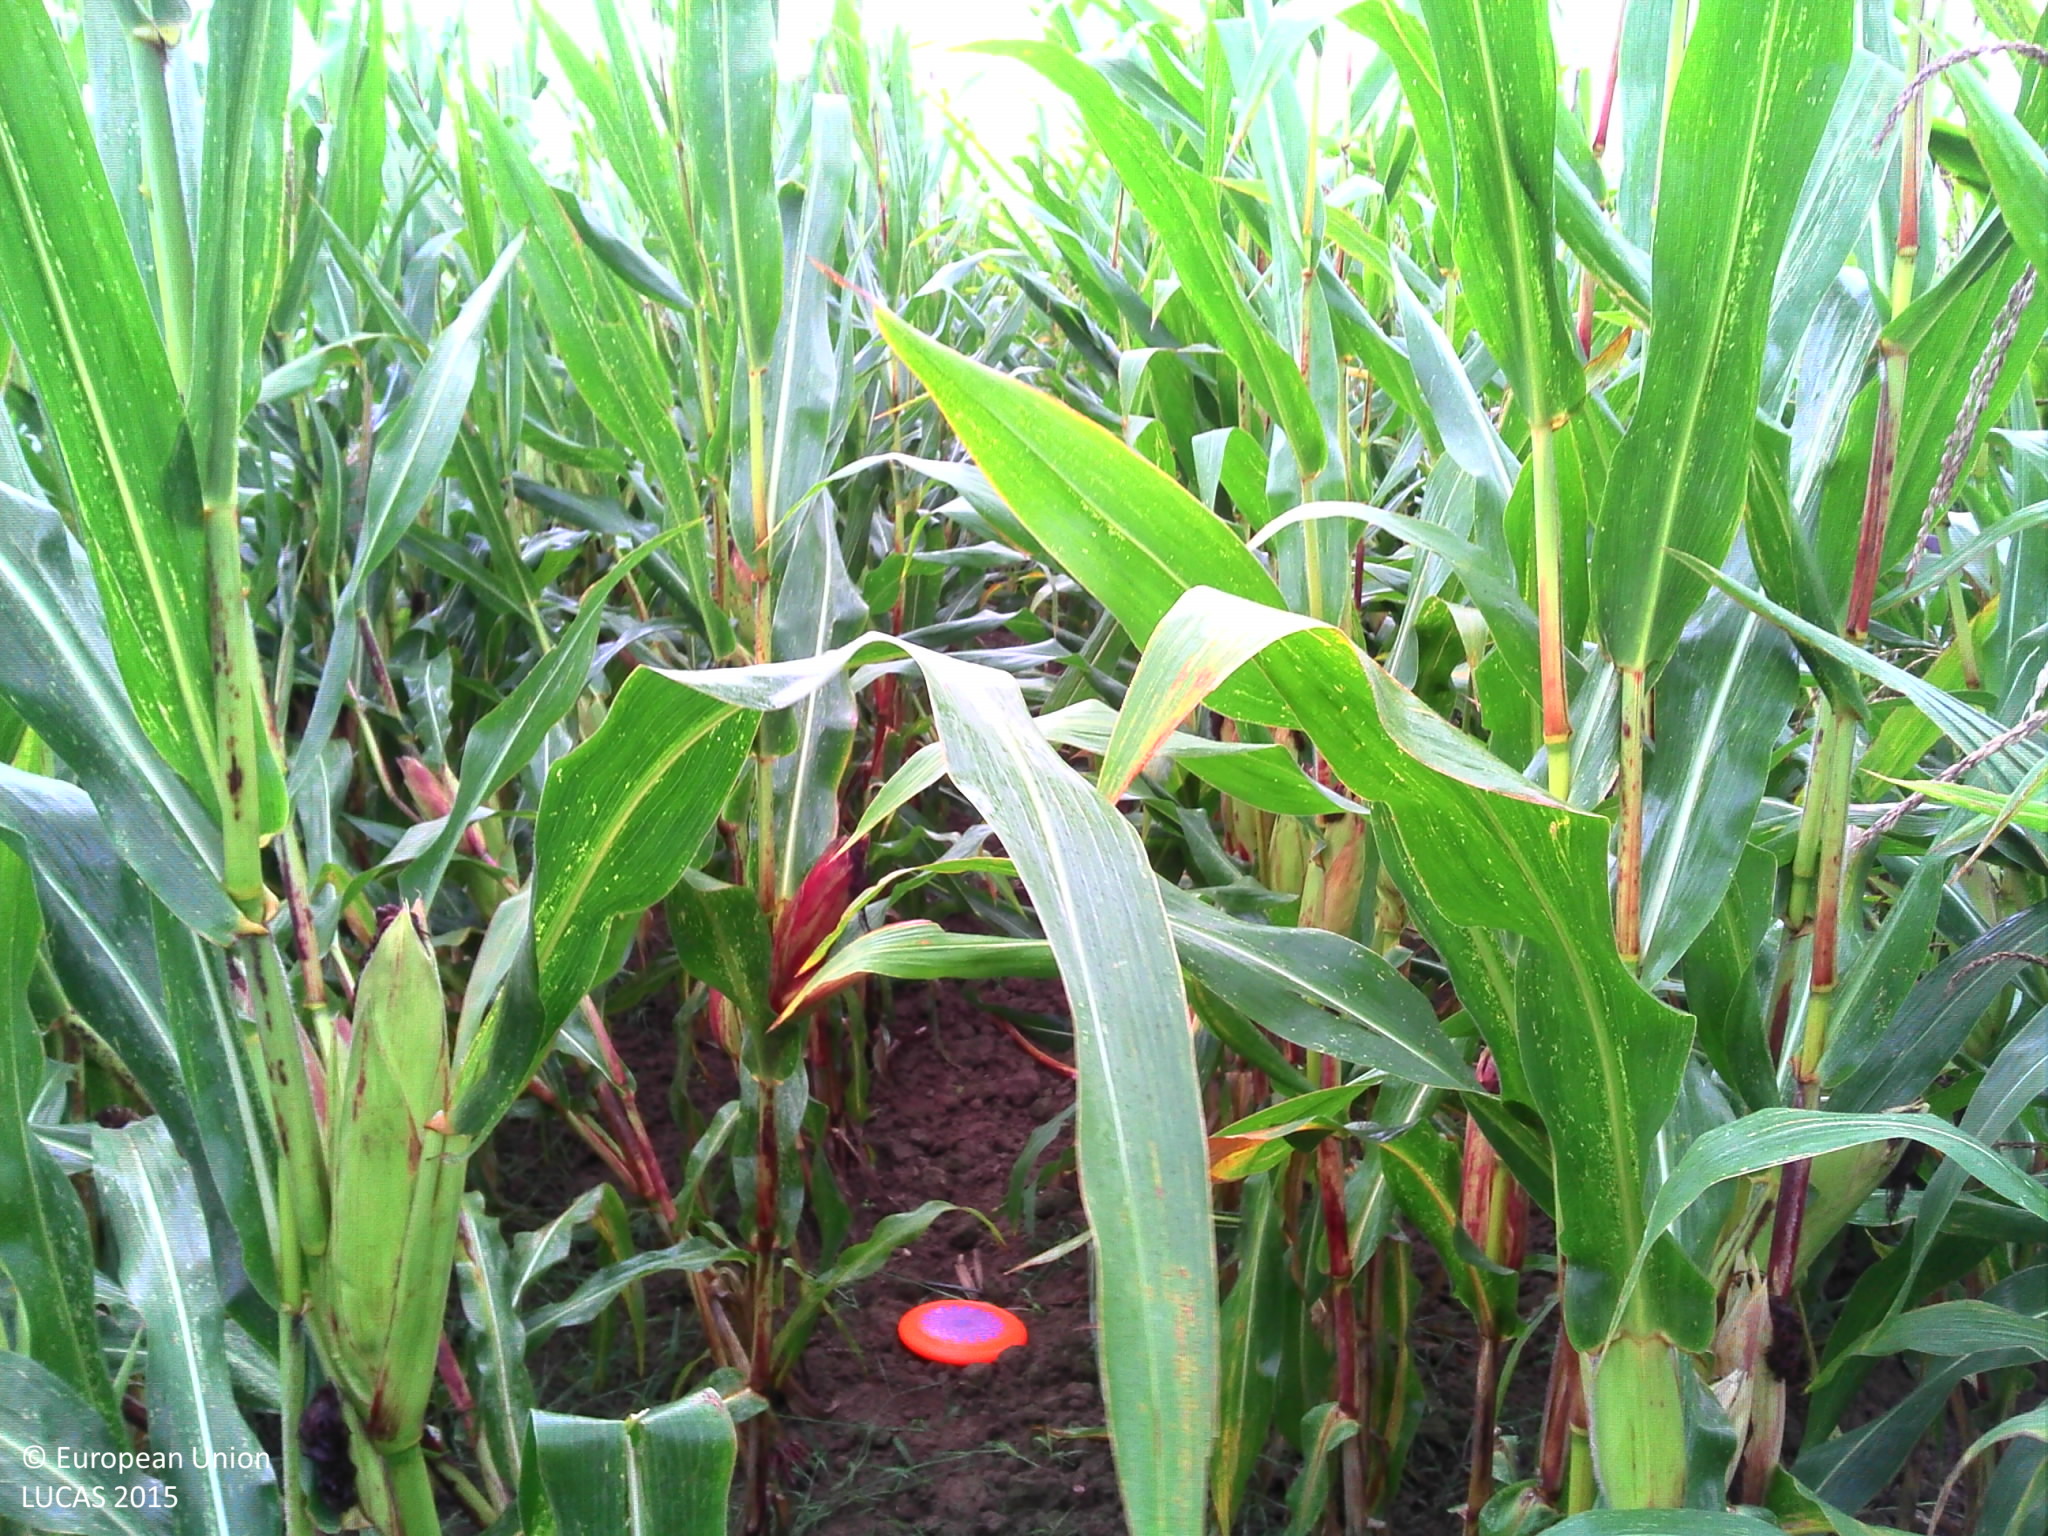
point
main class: Cropland
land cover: Maize
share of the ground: > 75 %
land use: Agriculture (excluding fallow land and kitchen gardens)
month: September
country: FR
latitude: 46.6317
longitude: -1.3878
